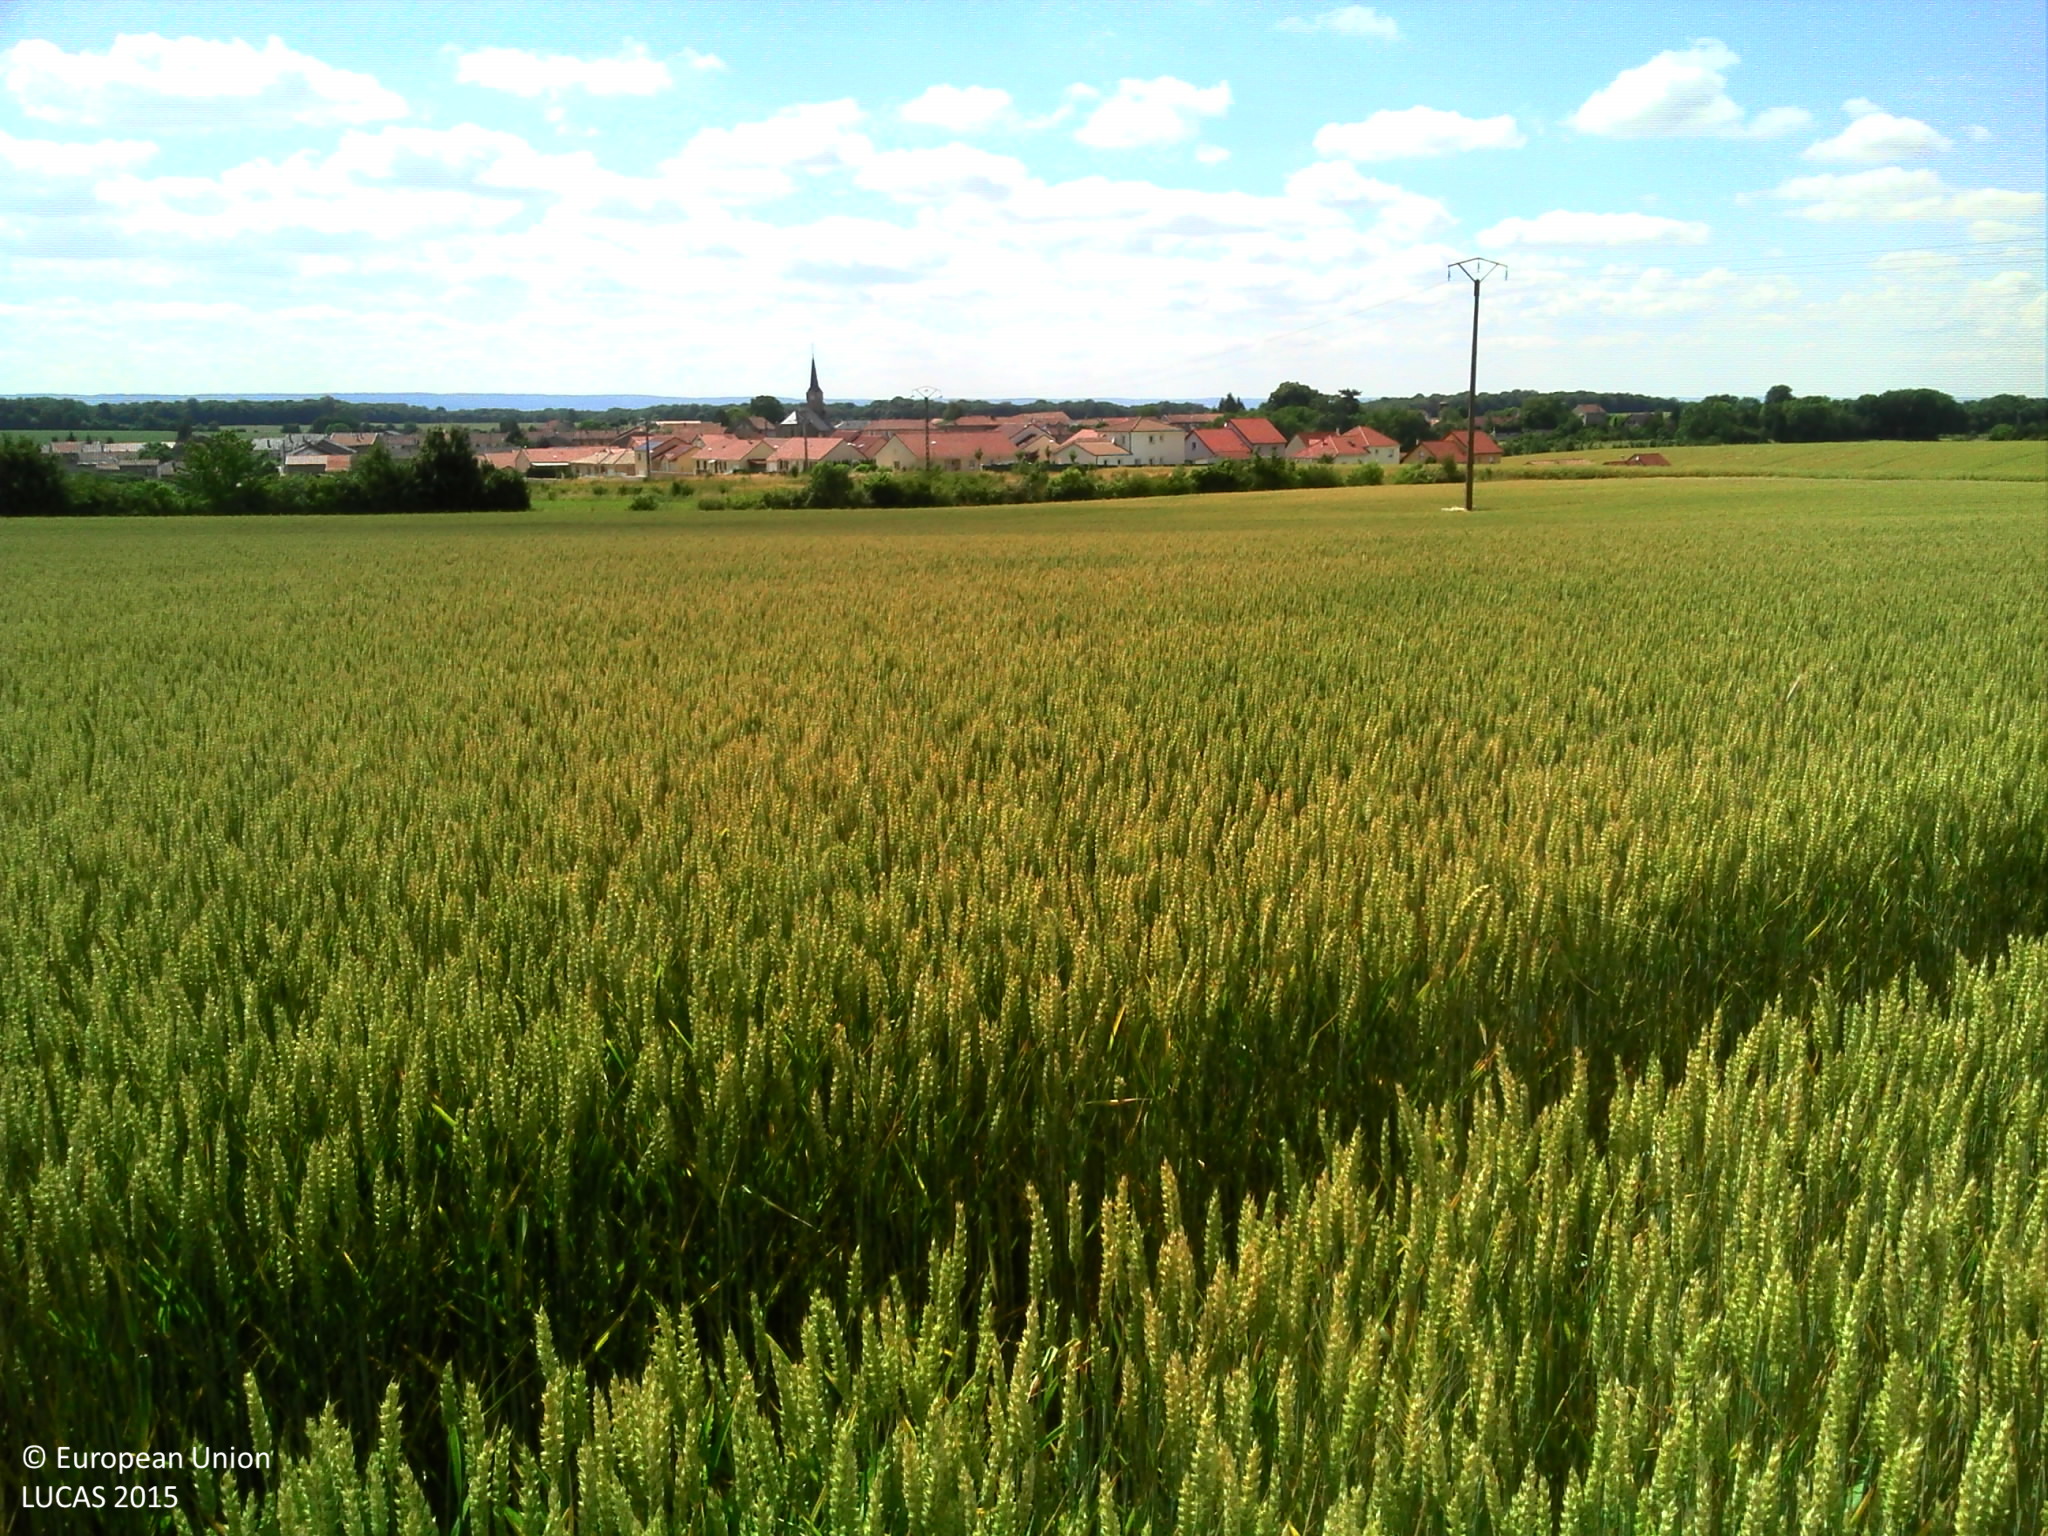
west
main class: Cropland
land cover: Common wheat
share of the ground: > 75 %
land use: Agriculture (excluding fallow land and kitchen gardens)
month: June
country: FR
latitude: 49.0484
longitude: 5.9085
